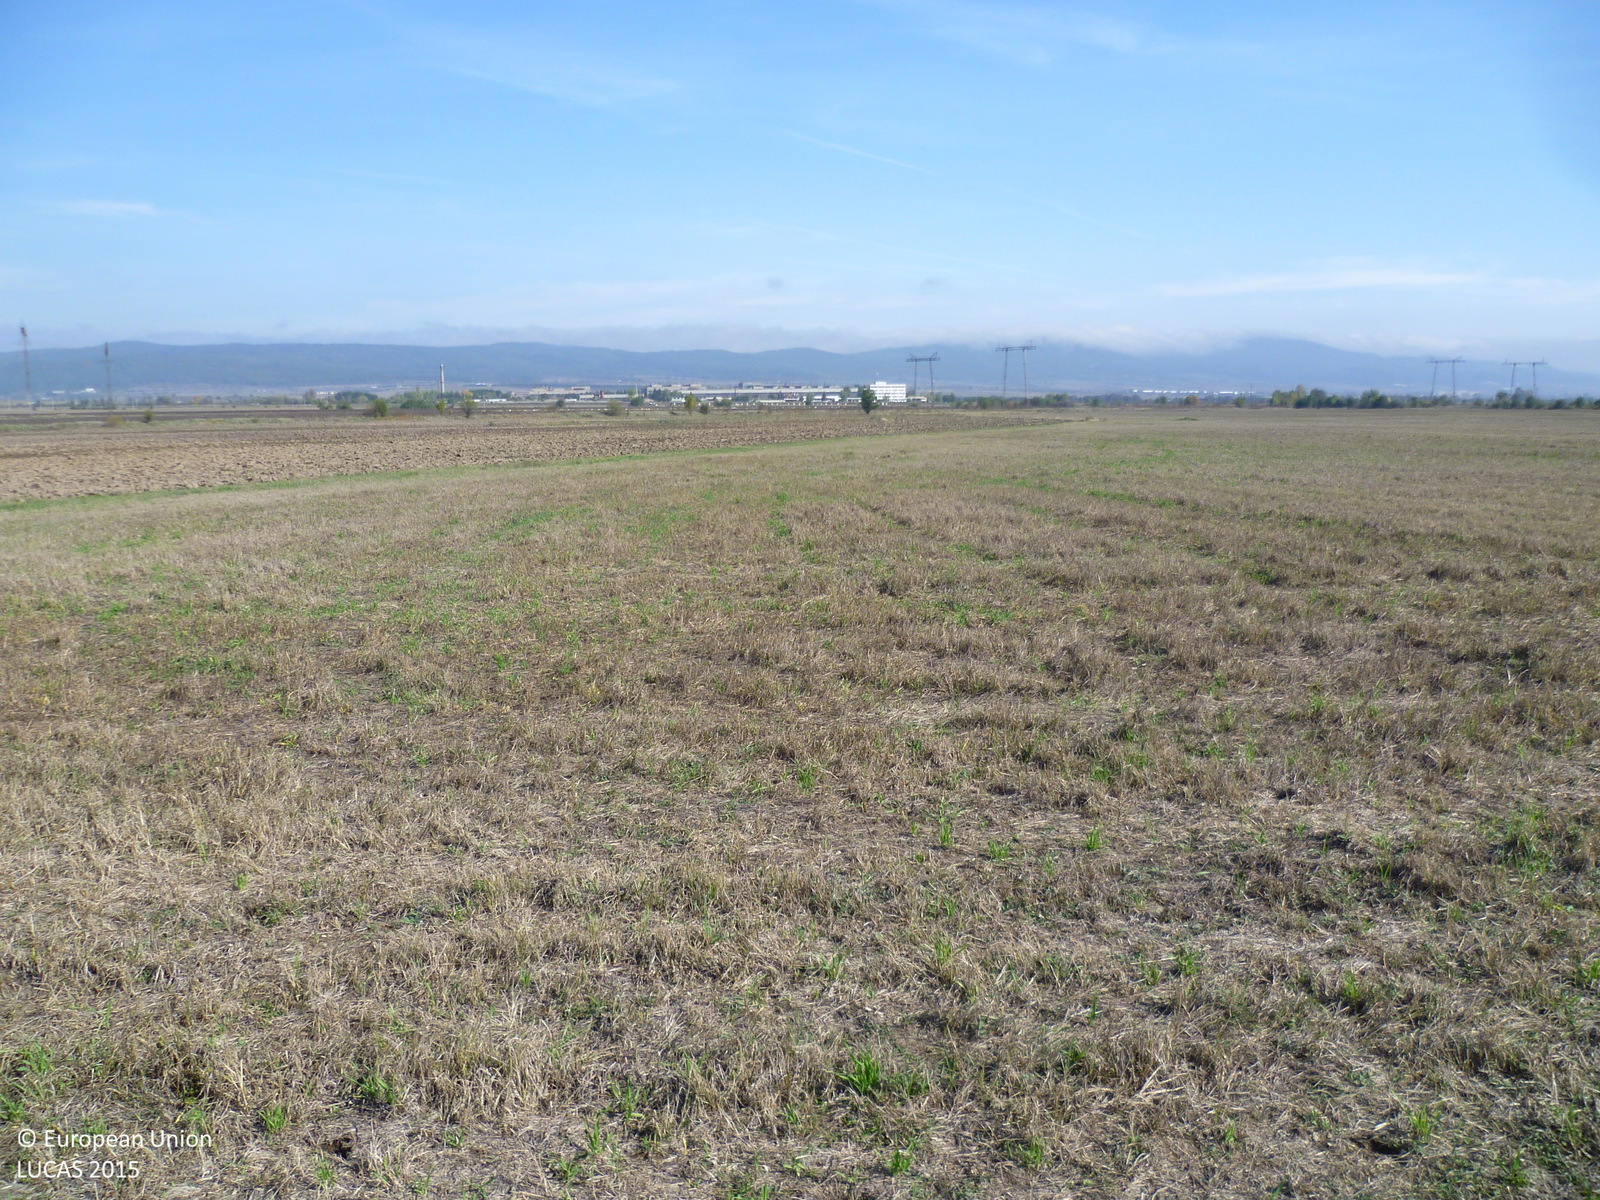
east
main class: Grassland
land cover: Grassland without tree/shrub cover
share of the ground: > 75 %
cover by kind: herbaceous plants 100 %
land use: Agriculture (excluding fallow land and kitchen gardens)
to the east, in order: Tracks; Grassland without tree/shrub cover; Other bare soil
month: October
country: BG
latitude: 42.4621
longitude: 23.7438
